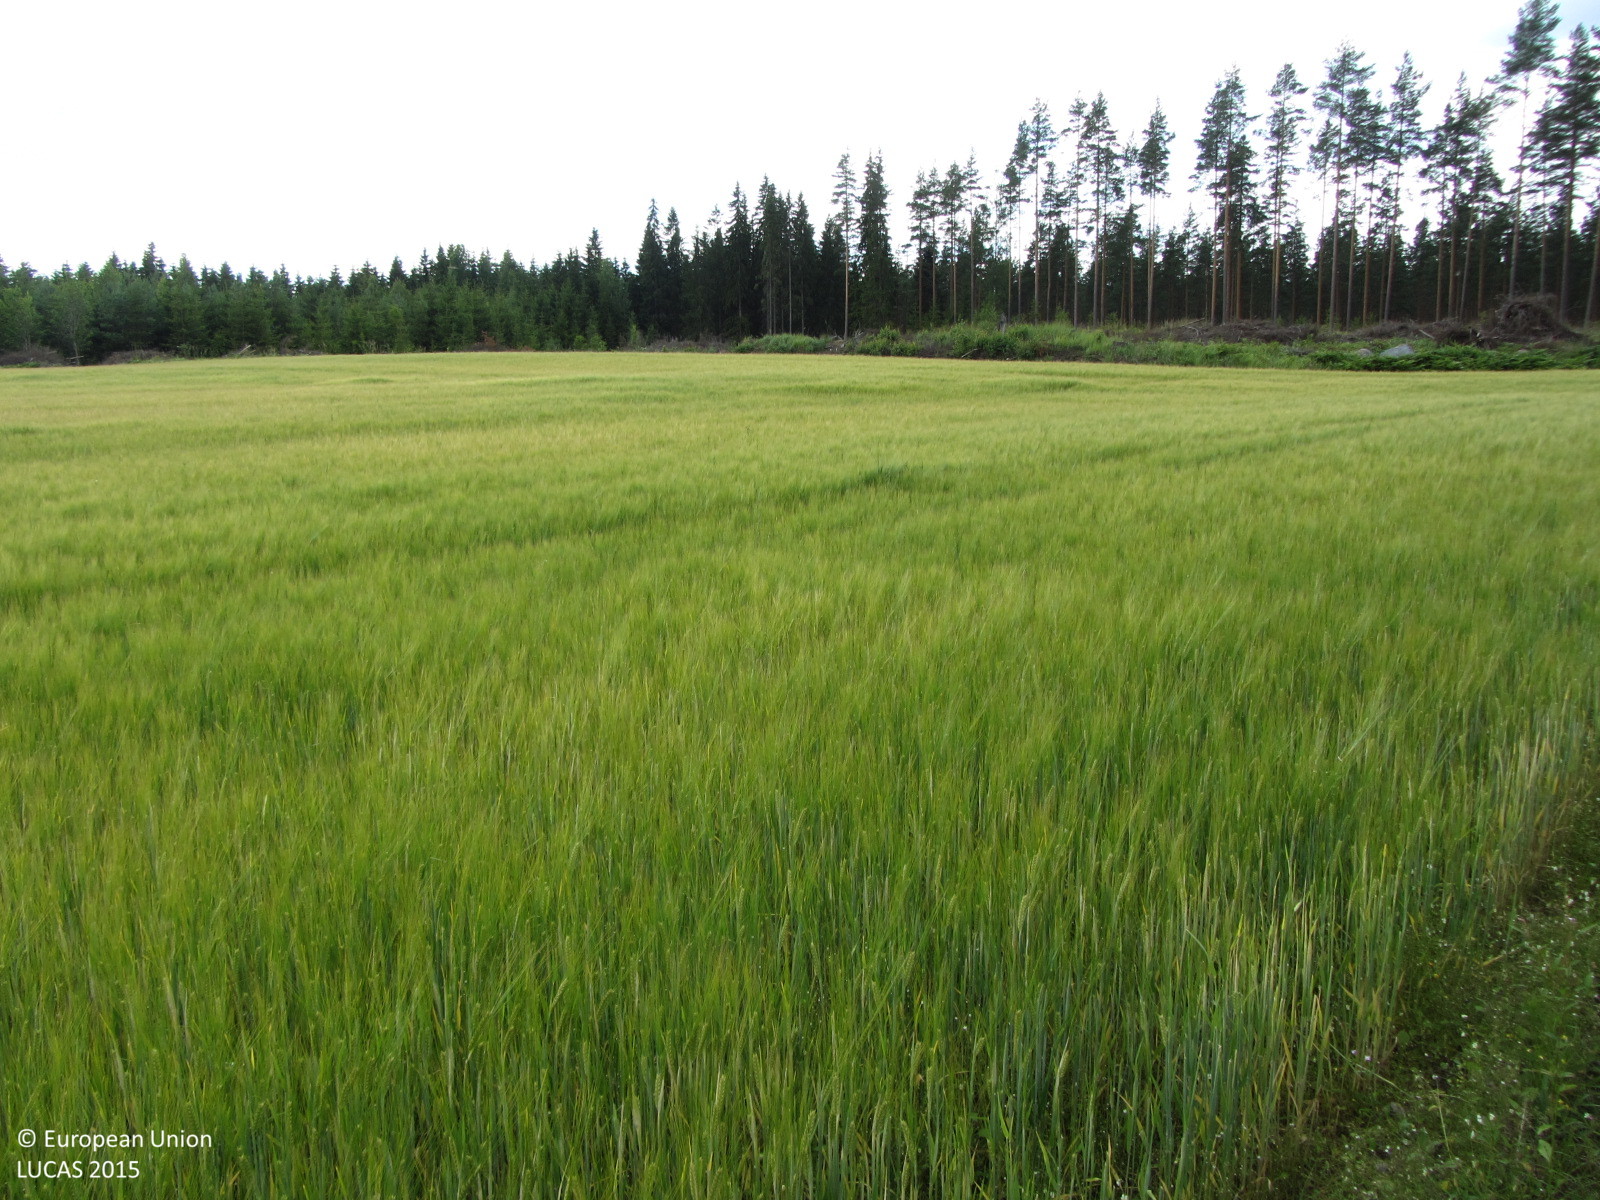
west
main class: Cropland
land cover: Barley
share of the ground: > 75 %
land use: Agriculture (excluding fallow land and kitchen gardens)
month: July
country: FI
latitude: 60.6729
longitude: 24.5097
